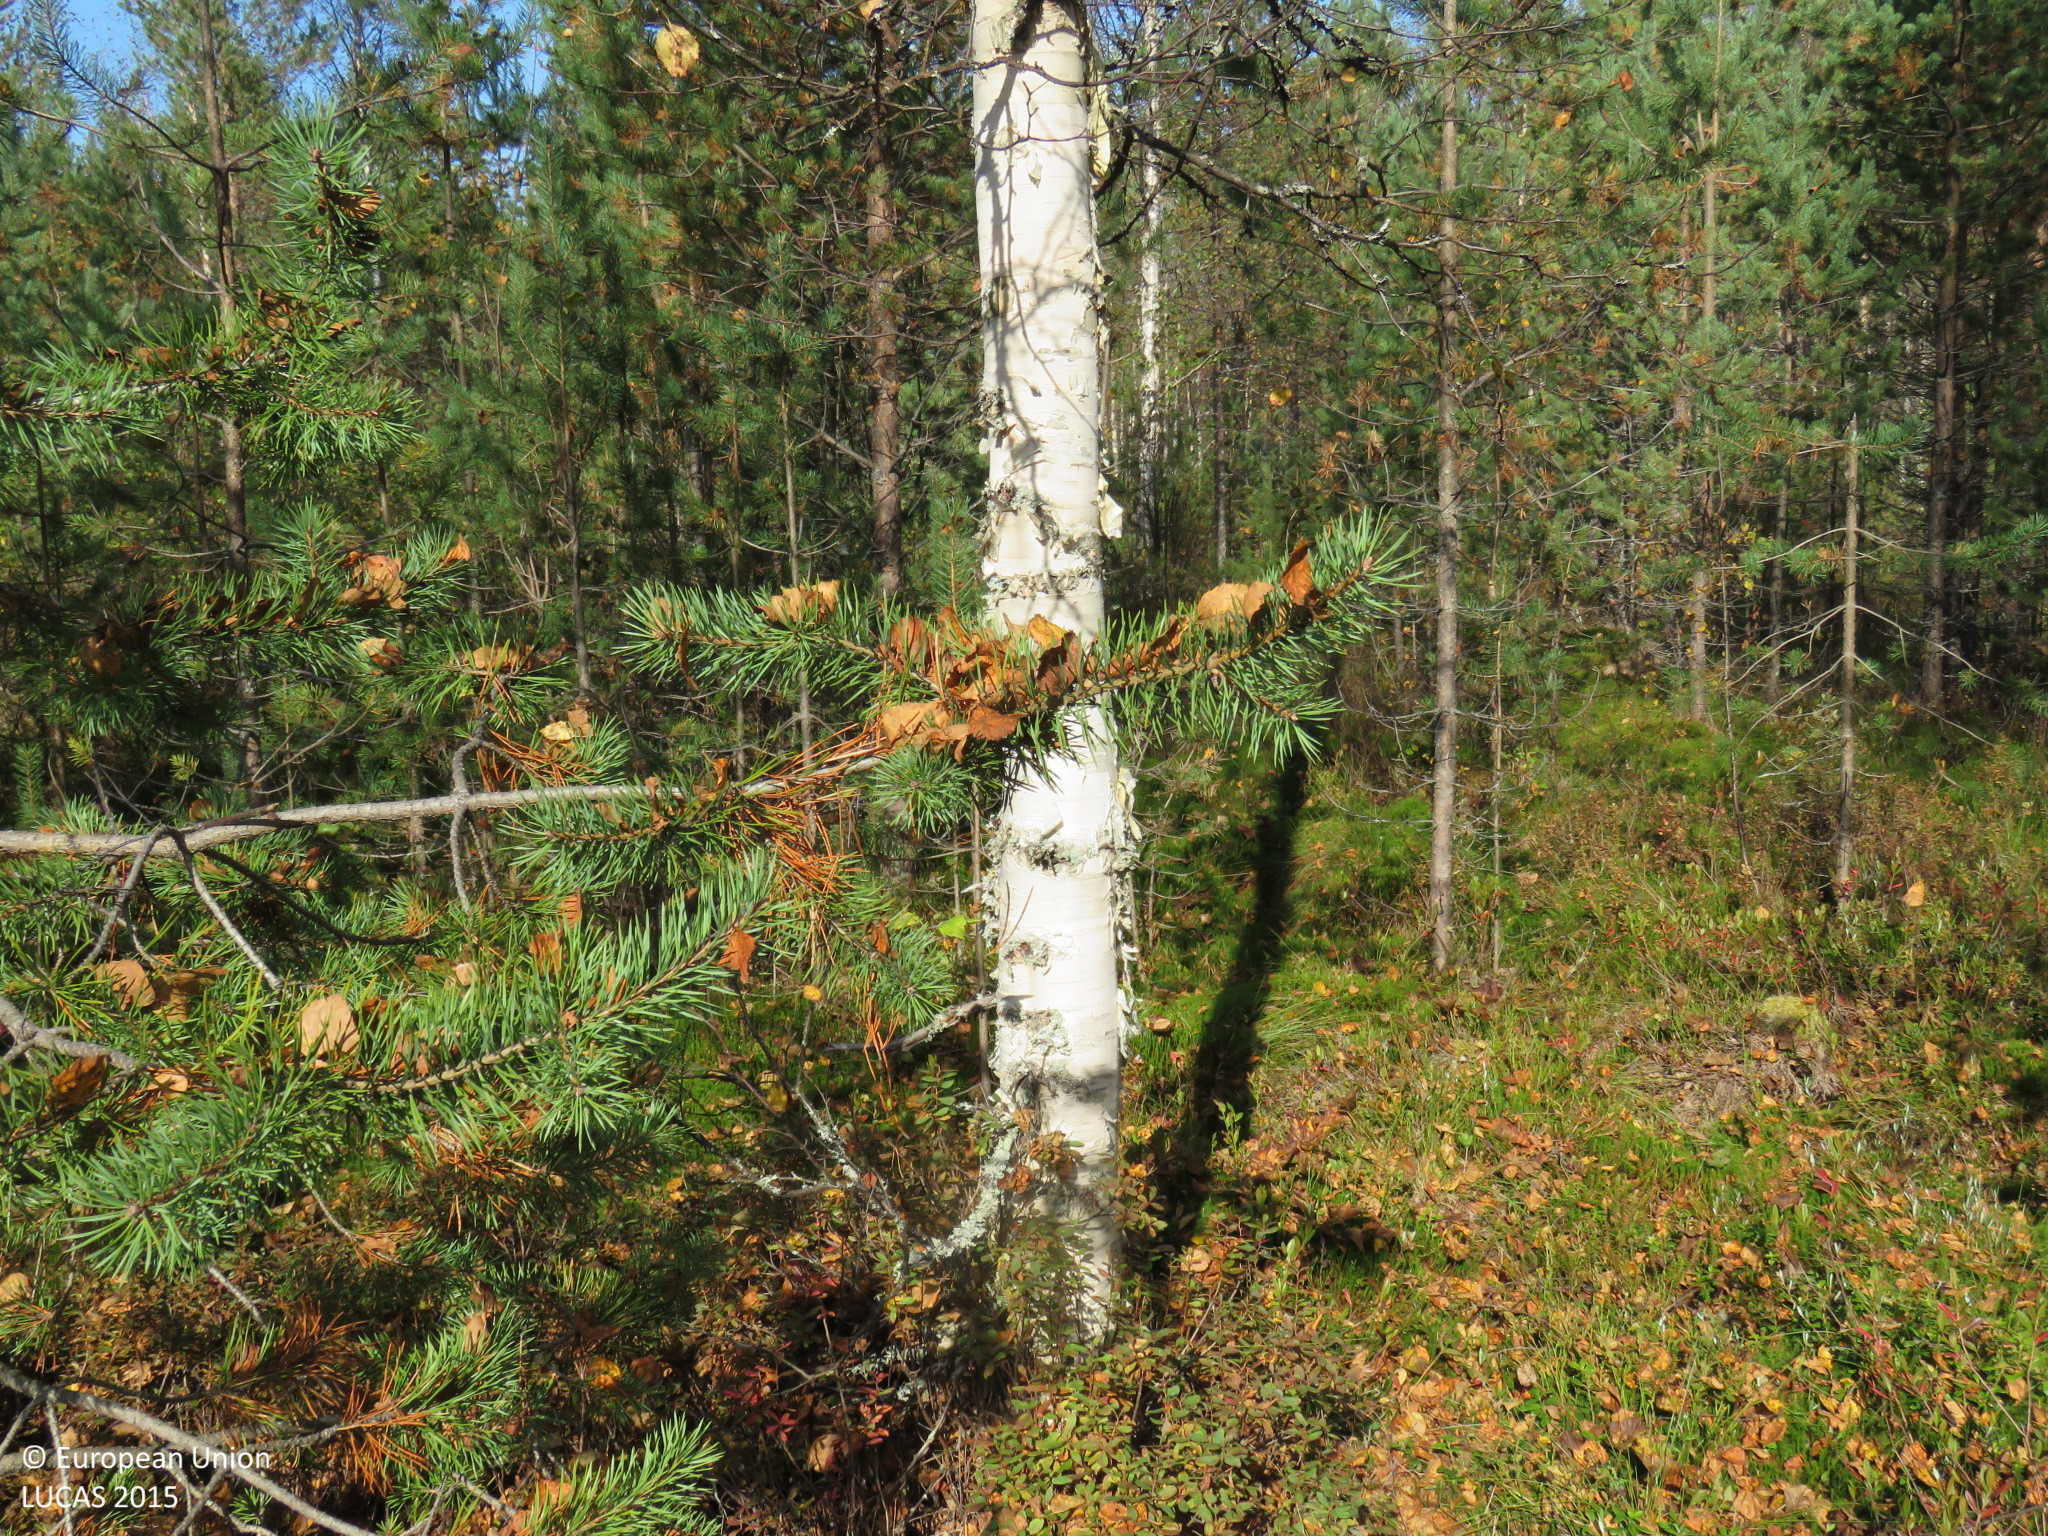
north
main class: Woodland
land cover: Pine dominated mixed woodland
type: mire and swamp forests
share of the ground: > 75 %
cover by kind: broadleaved forest trees 50 %, coniferous forest trees 30 %, shrubs 15 %, lichens and mosses 5 %
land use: Forestry
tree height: > 5 m
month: September
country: FI
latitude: 65.0828
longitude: 26.5083
